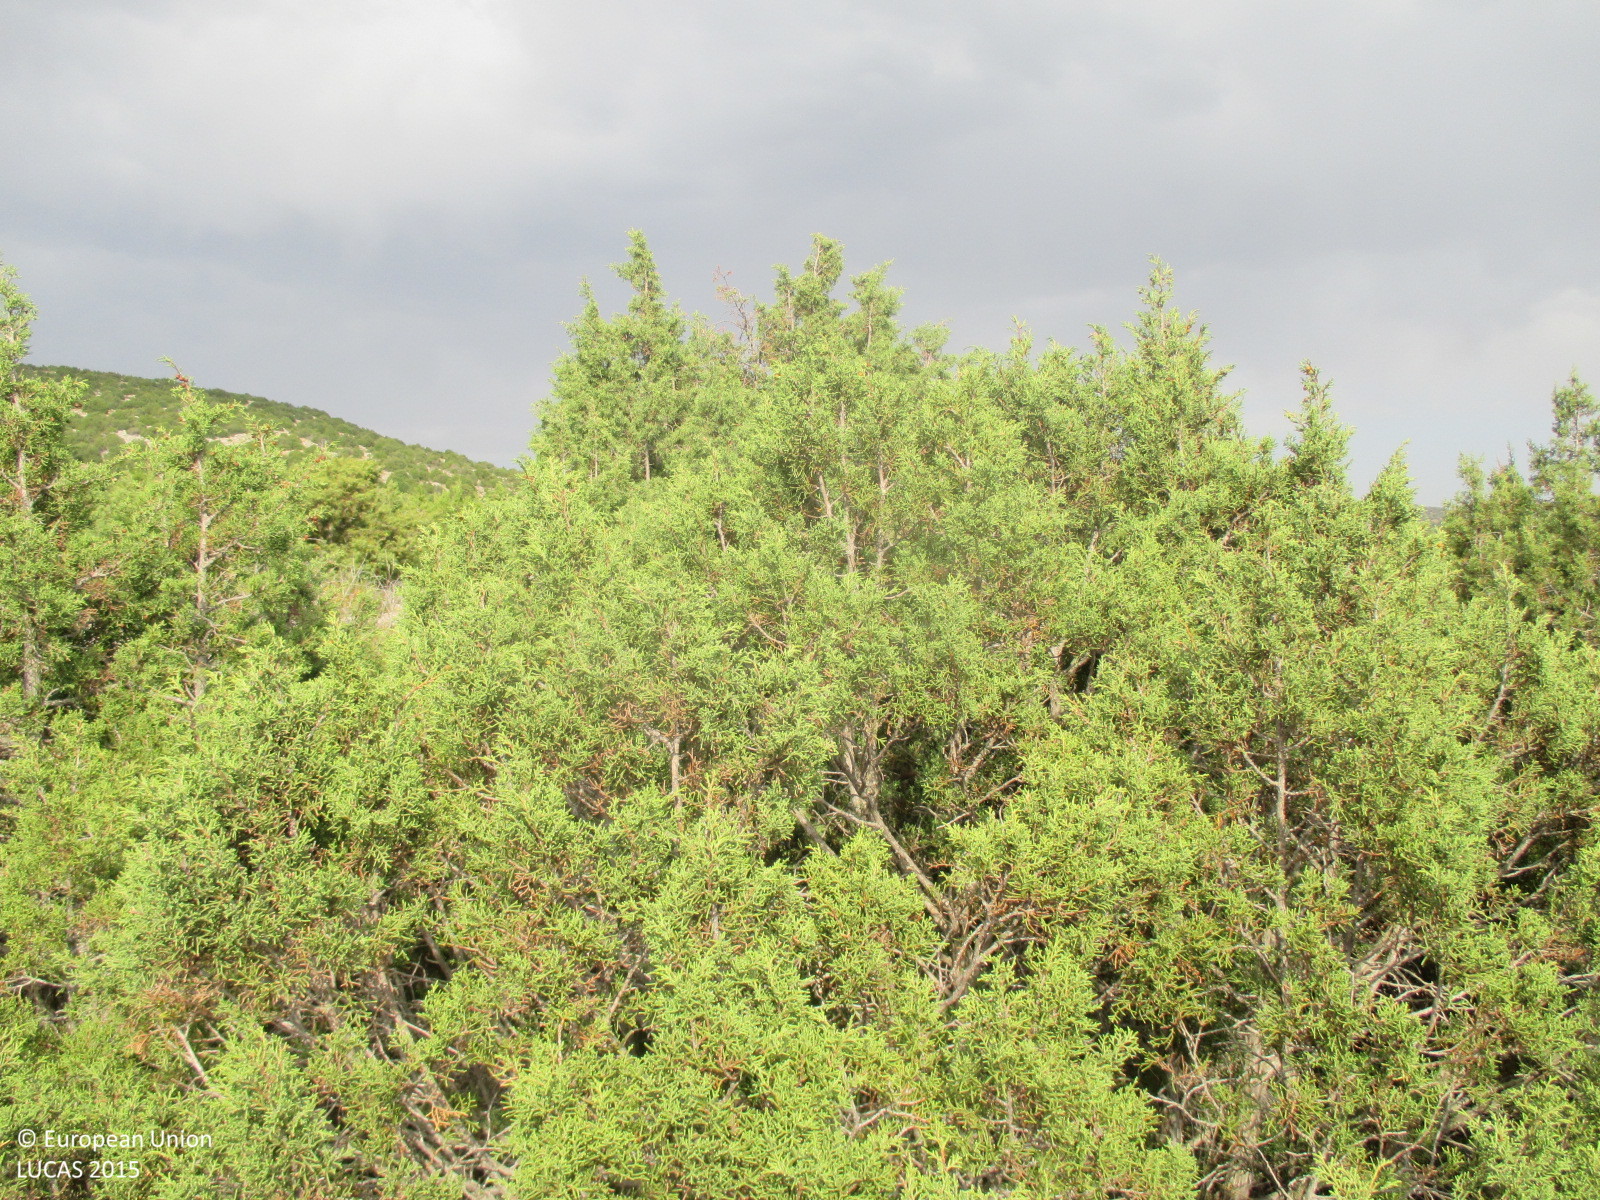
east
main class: Shrubland
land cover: Shrubland without tree cover
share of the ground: 50 - 75 %
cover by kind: shrubs 50 %, herbaceous plants 30 %, consolidated bare surface 20 %
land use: Semi-natural and natural areas not in use
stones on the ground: < 10 %
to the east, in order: Shrubland without tree cover; Paved roads, cycling and walking lanes; Grassland without tree/shrub cover; Fences; Shrubland without tree cover
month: July
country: ES
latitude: 38.1929
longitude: -2.4285
